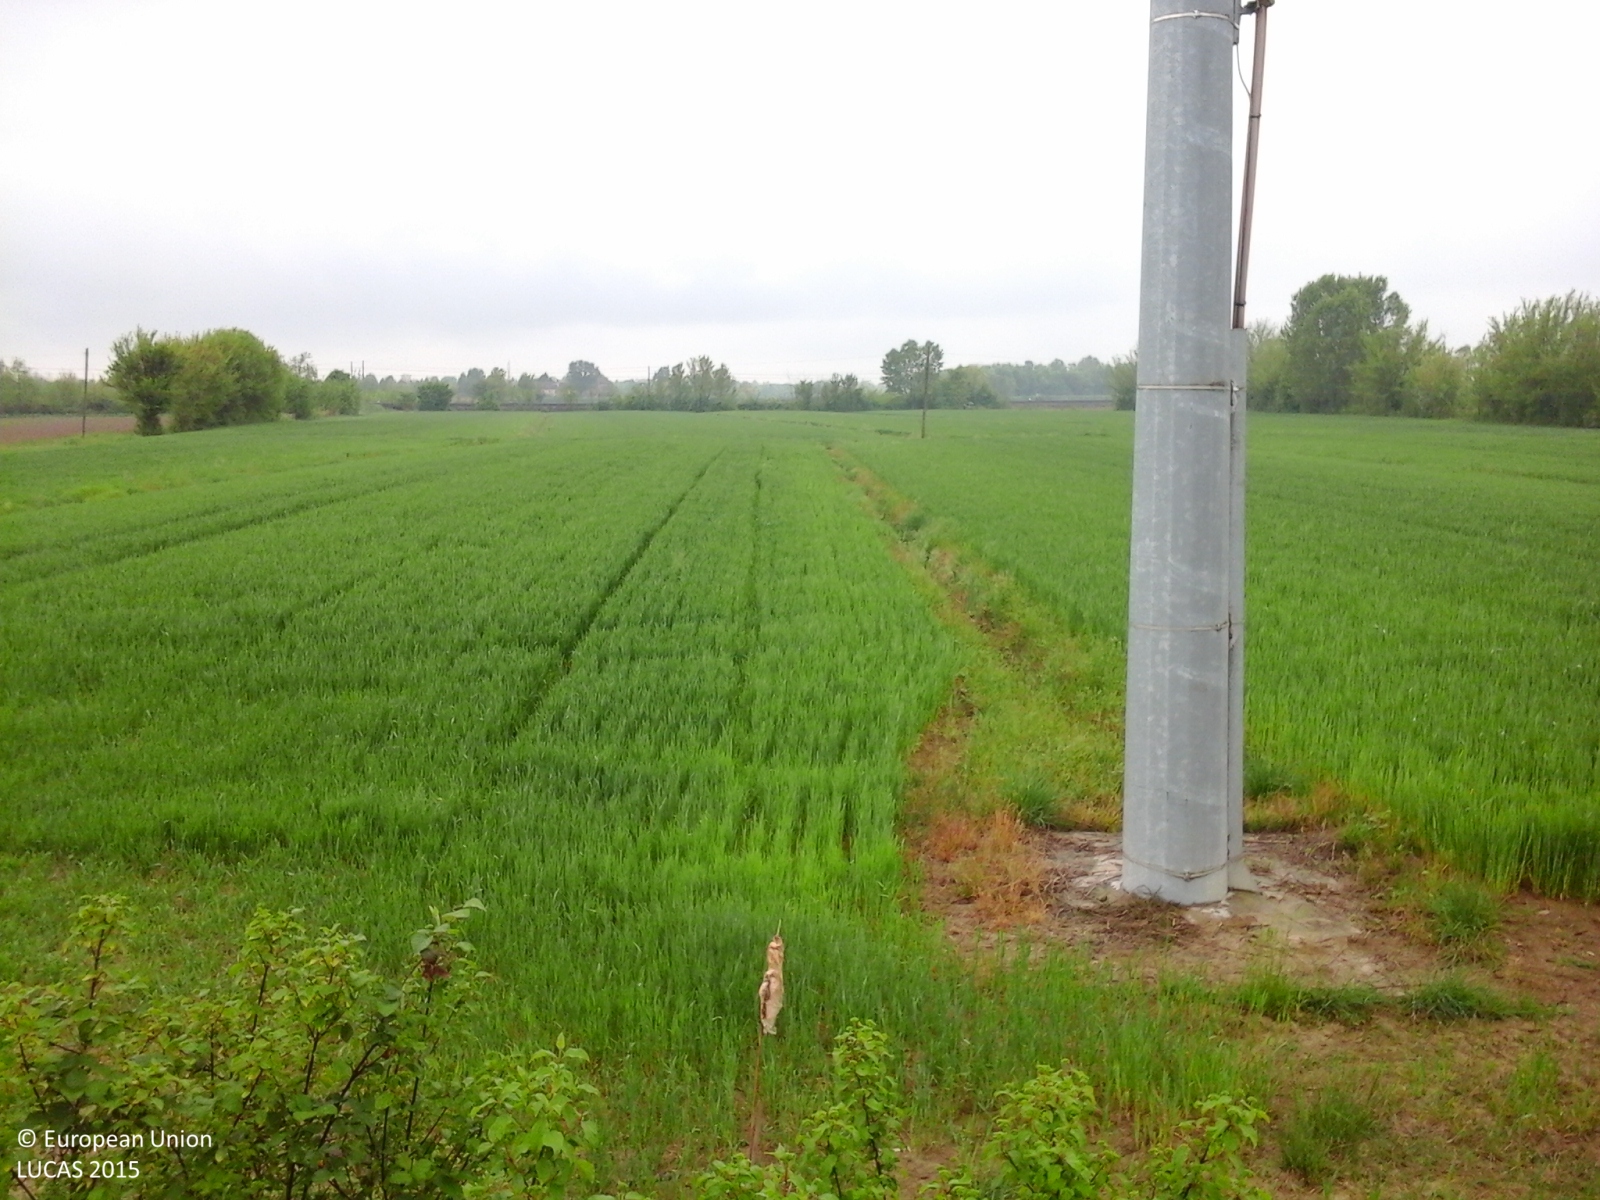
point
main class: Cropland
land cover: Common wheat
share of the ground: > 75 %
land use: Agriculture (excluding fallow land and kitchen gardens)
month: April
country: IT
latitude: 45.5337
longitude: 12.2886
